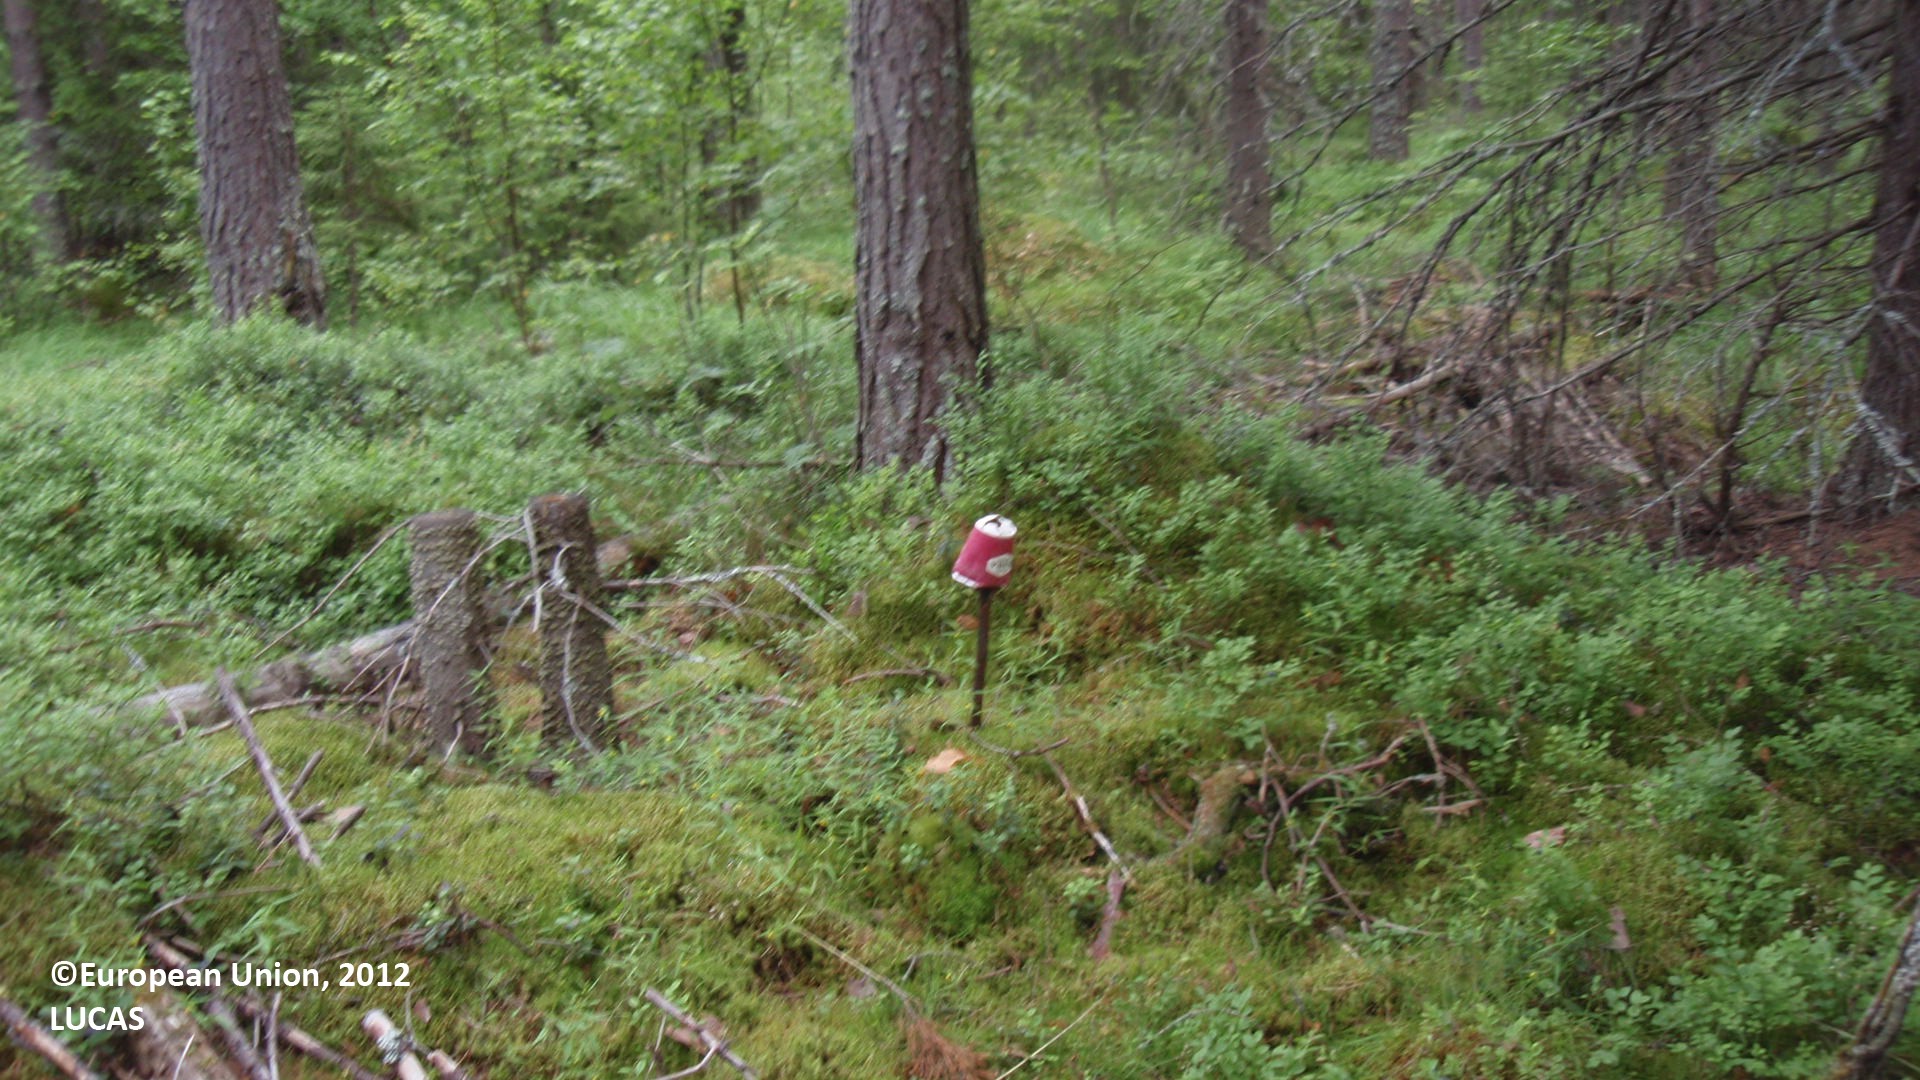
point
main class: Woodland
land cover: Spruce dominated mixed woodland
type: boreal forest
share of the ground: 50 - 75 %
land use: Forestry
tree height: > 5 m
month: July
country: FI
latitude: 61.4331
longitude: 28.7626
